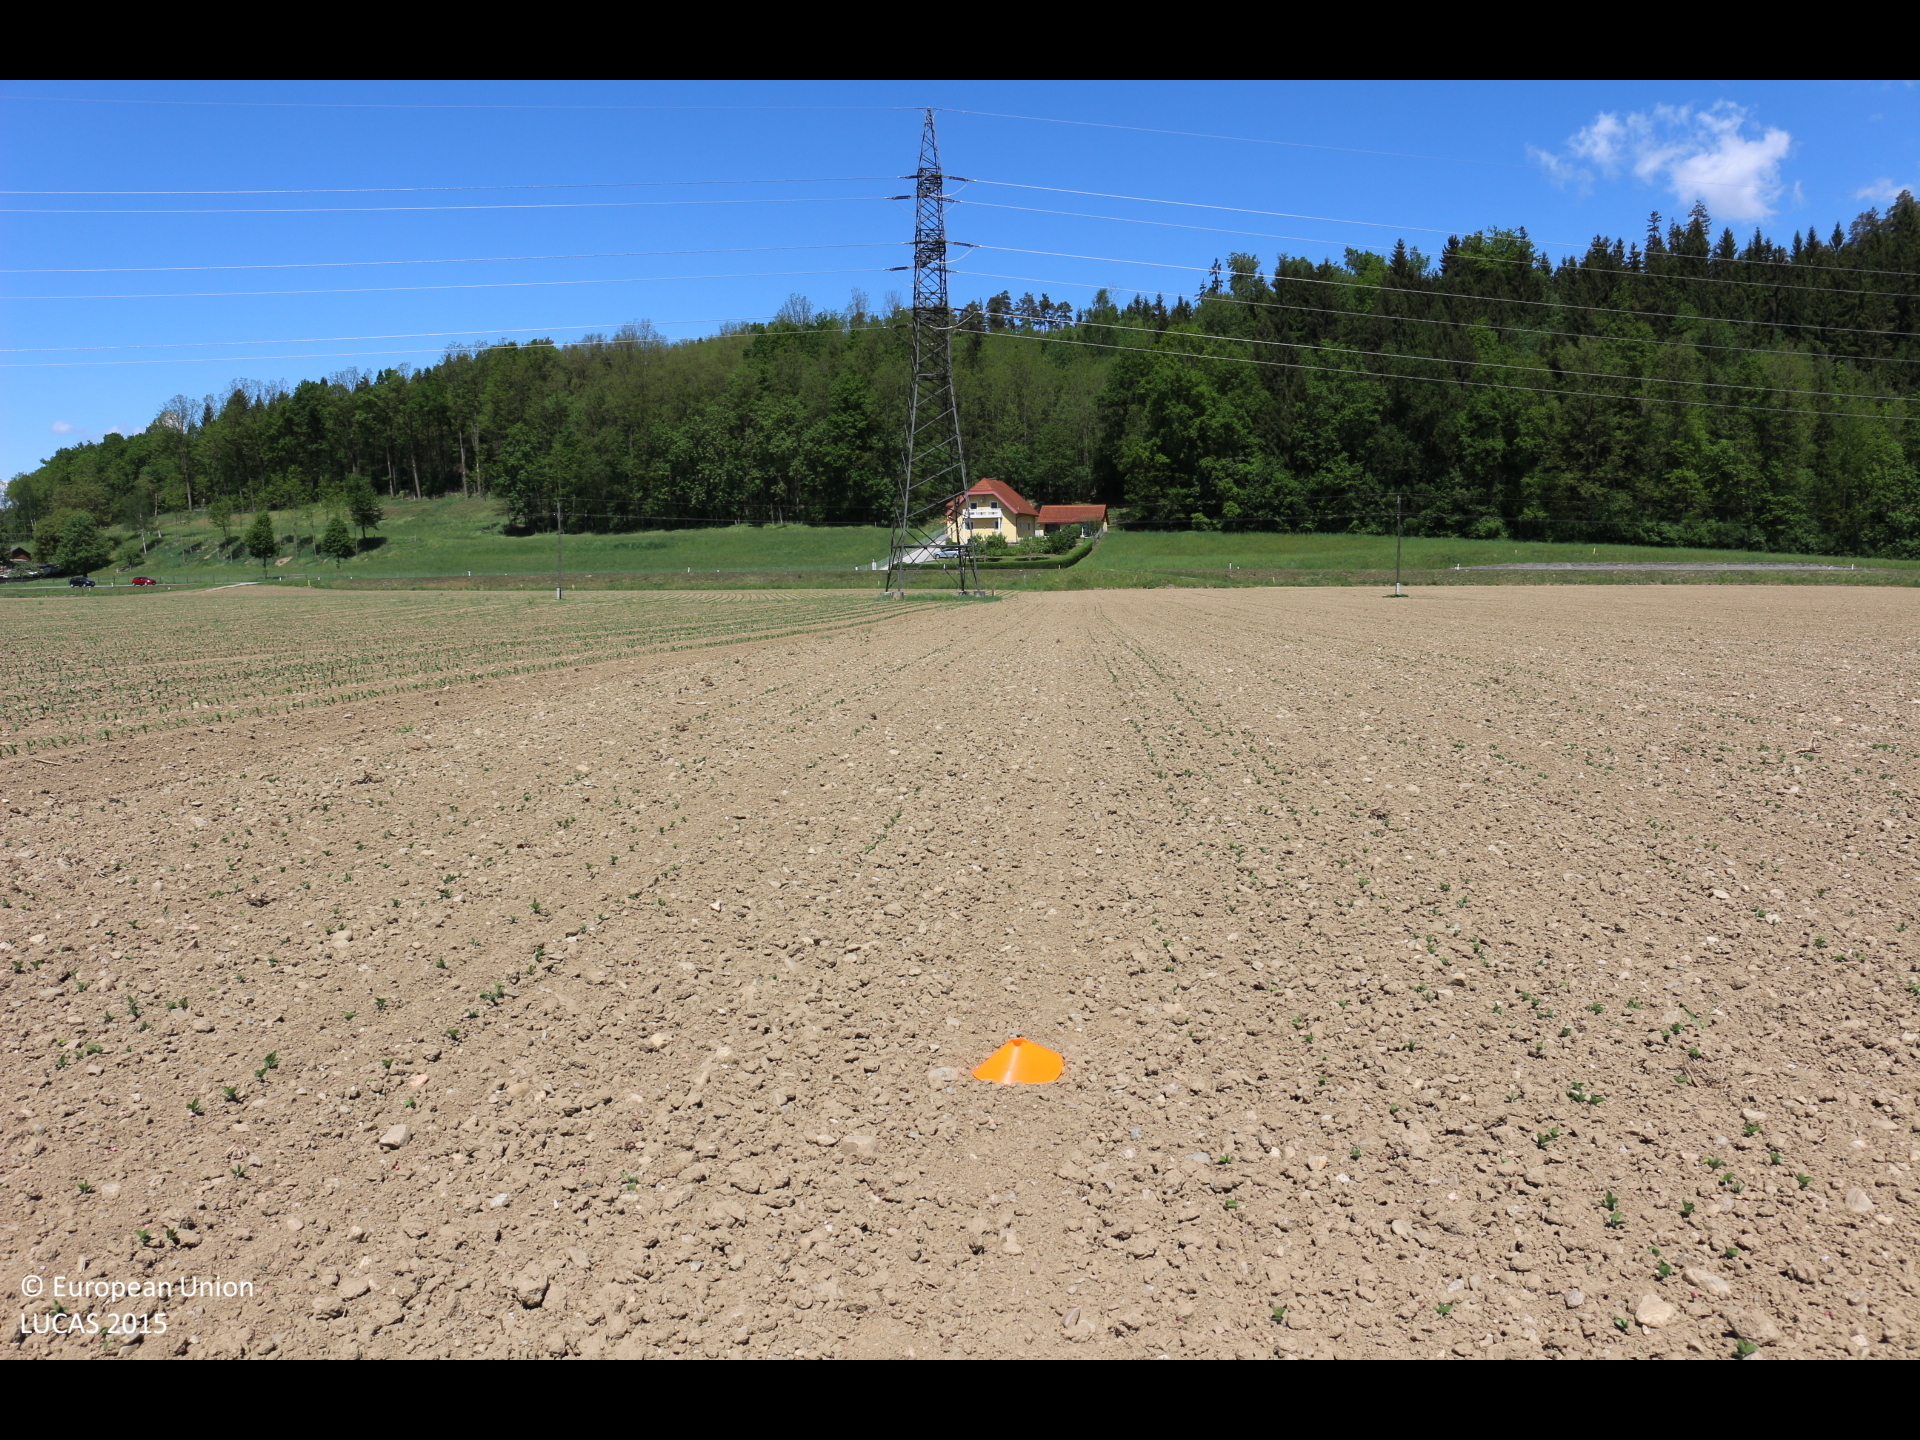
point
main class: Cropland
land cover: Soya
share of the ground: < 10 %
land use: Agriculture (excluding fallow land and kitchen gardens)
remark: Tilled/Sowed
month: May
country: AT
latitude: 46.6743
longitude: 14.4291
